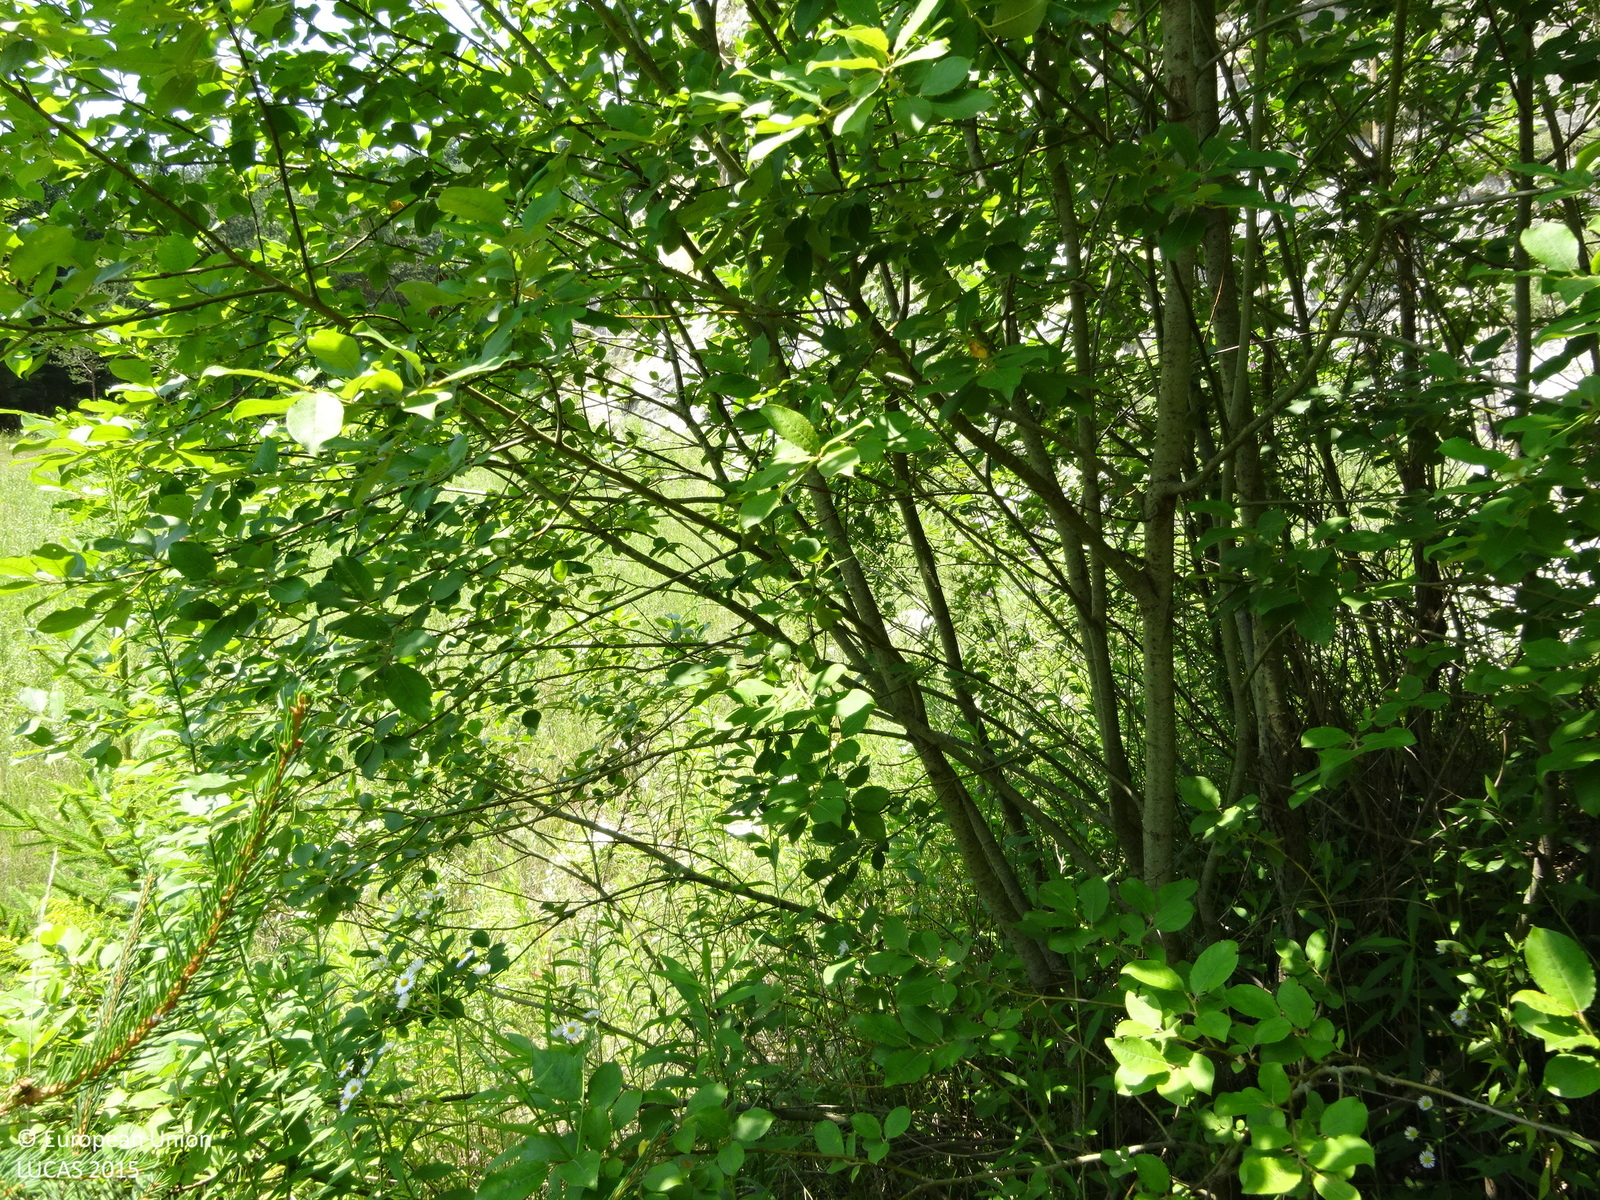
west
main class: Shrubland
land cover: Shrubland with sparse tree cover
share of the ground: 50 - 75 %
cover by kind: shrubs 75 %, herbaceous plants 20 %, coniferous forest trees 5 %
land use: Abandoned areas
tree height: > 5 m
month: July
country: AT
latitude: 47.1741
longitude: 15.3435
